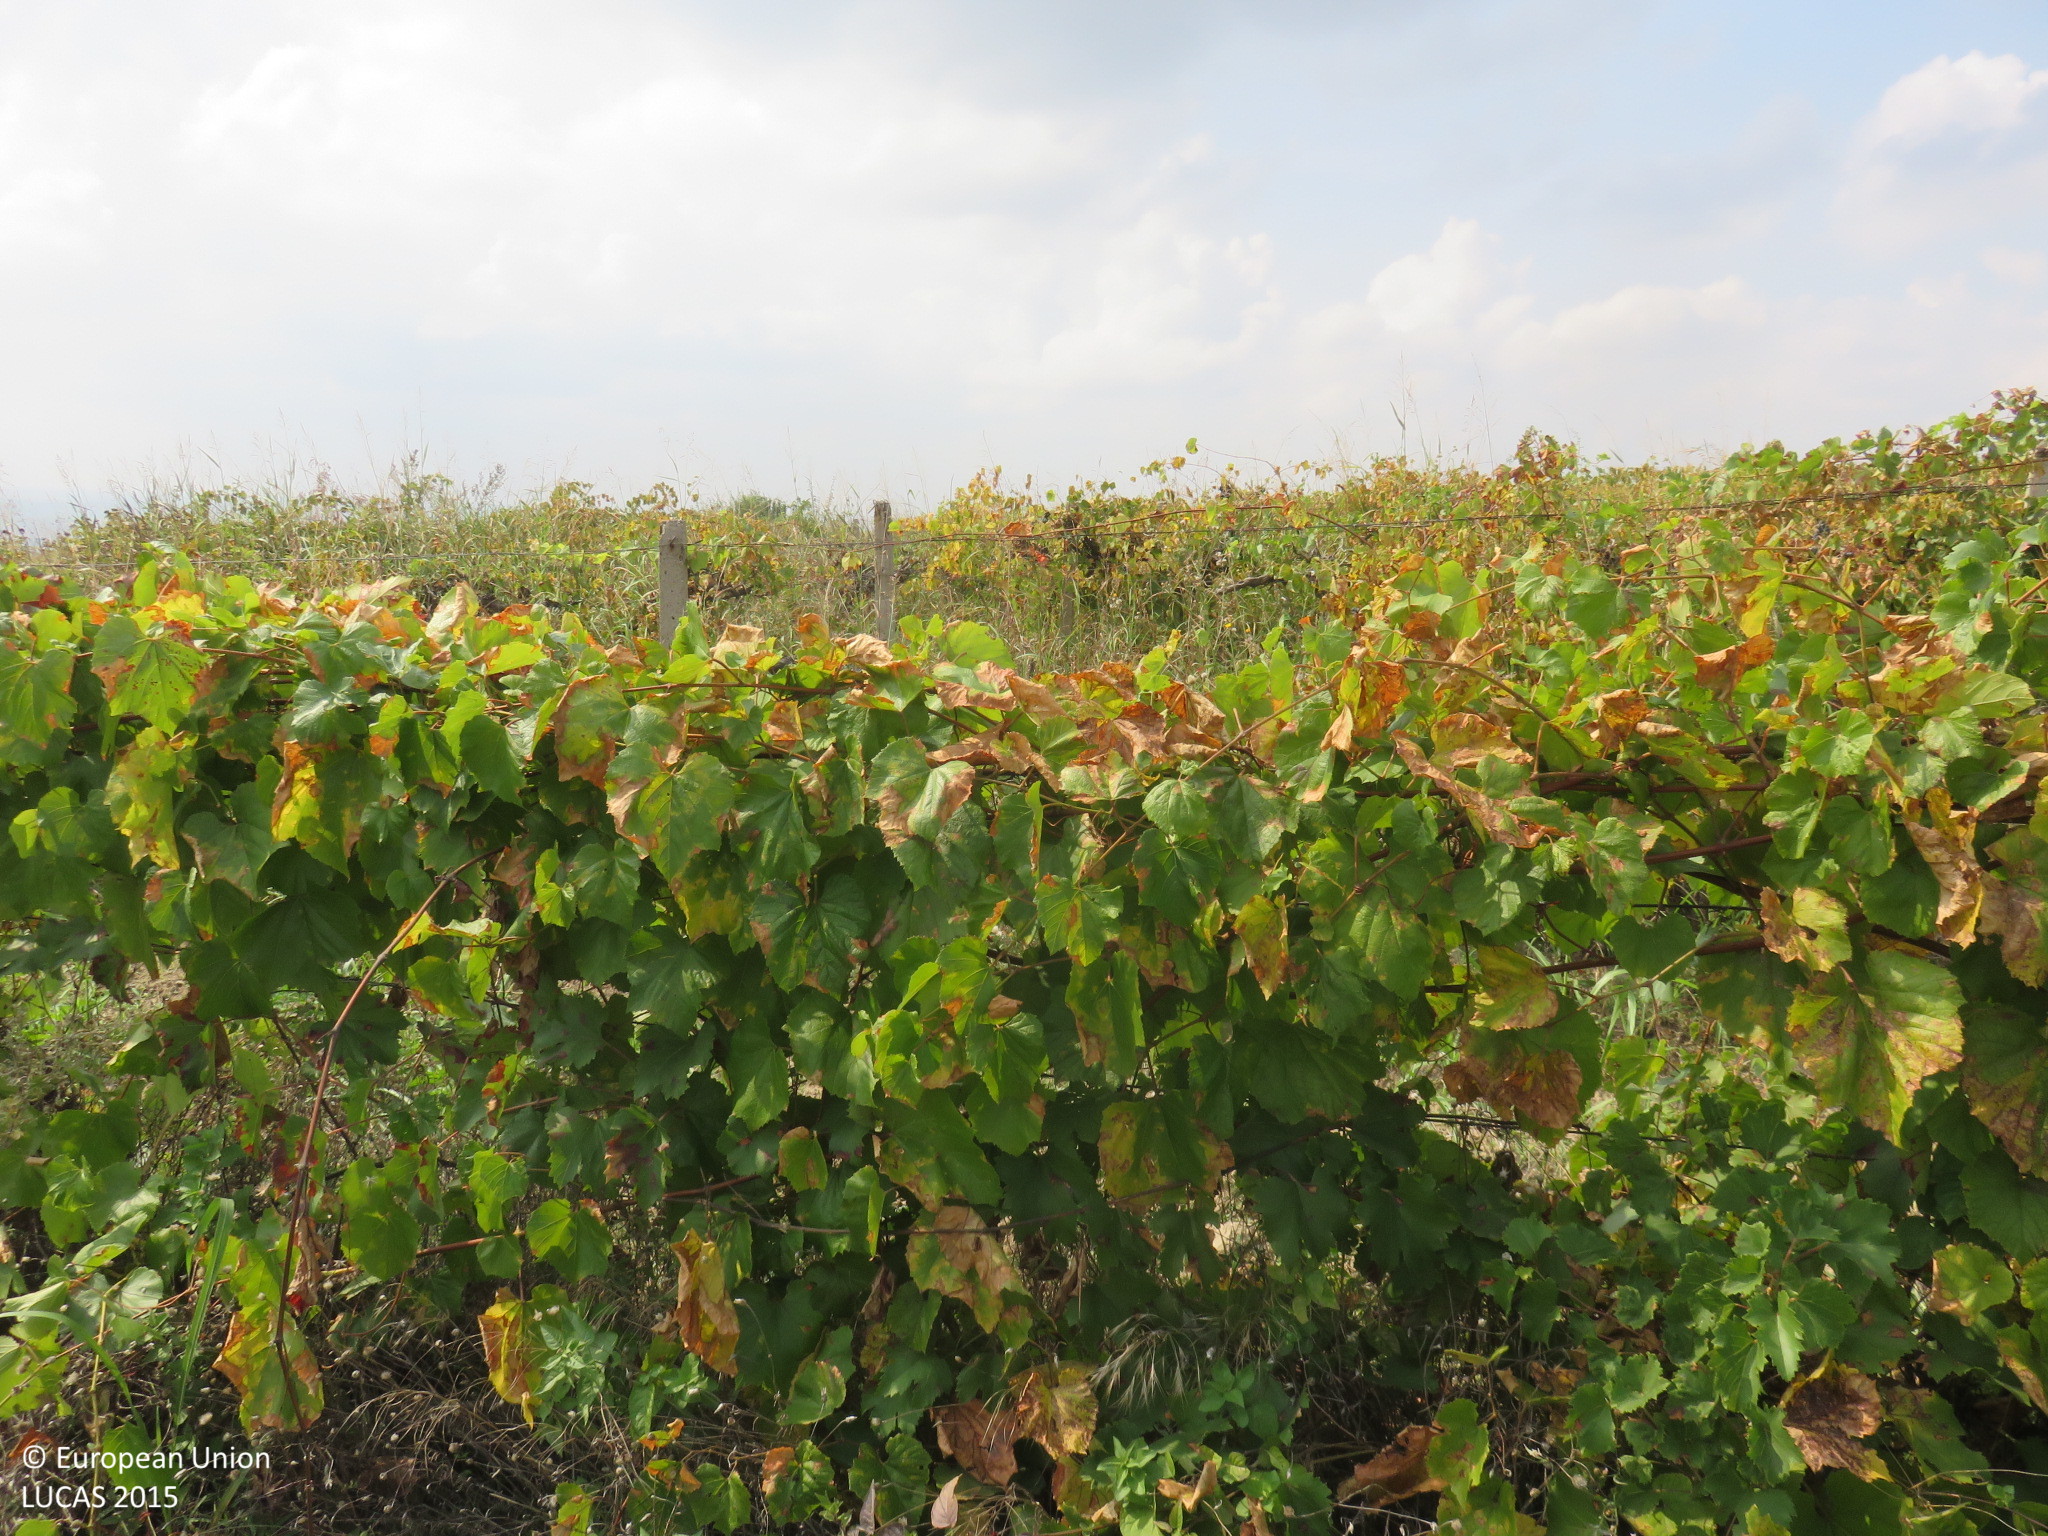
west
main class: Cropland
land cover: Vineyards
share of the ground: > 75 %
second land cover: Spontaneously vegetated surfaces
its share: 25 - 50 %
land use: Agriculture (excluding fallow land and kitchen gardens)
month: September
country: BG
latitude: 43.6118
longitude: 24.9270
